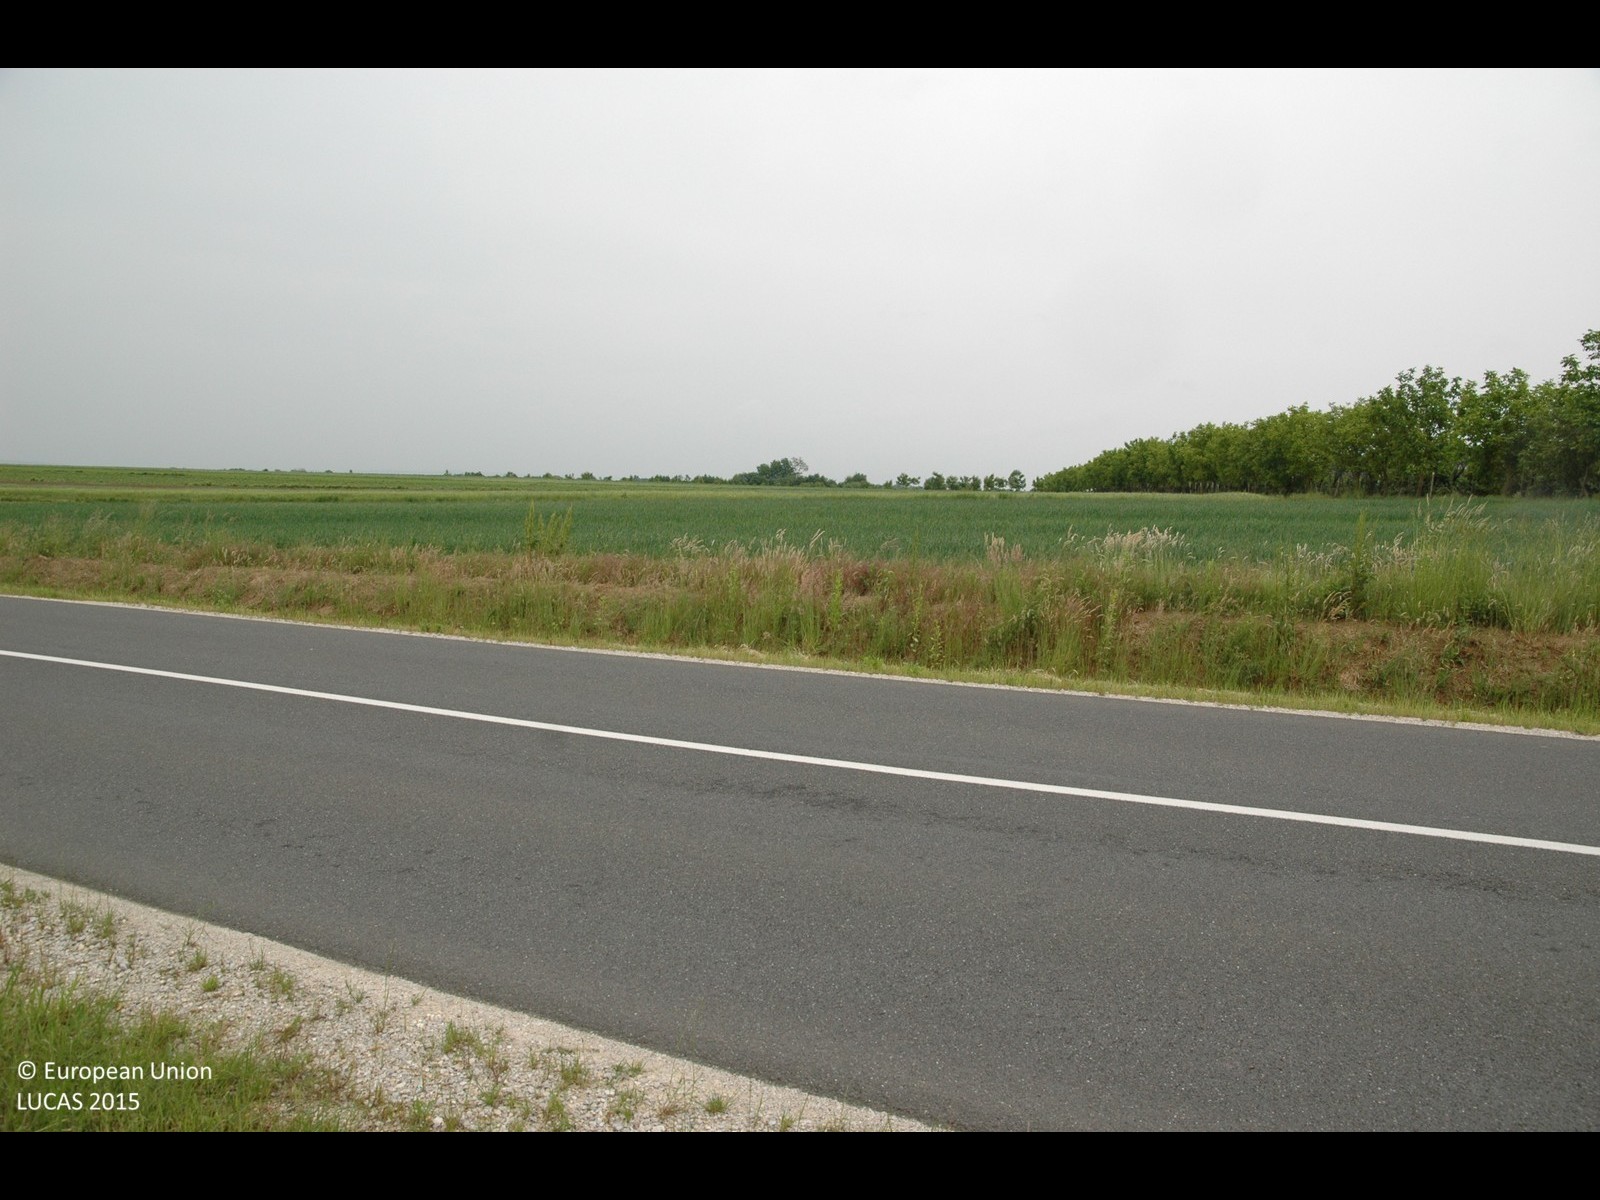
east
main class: Cropland
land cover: Apple fruit
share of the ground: 50 - 75 %
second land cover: Grassland without tree/shrub cover
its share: 50 - 75 %
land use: Agriculture (excluding fallow land and kitchen gardens)
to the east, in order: Apple fruit; Grassland without tree/shrub cover; Fences; Grass margins; Ditches and canals; Paved roads, cycling and walking lanes; Grass margins; Ditches and canals; Grass margins; Common wheat; Maize; Common wheat; Barley; Maize; Potatoes; Maize
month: May
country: HR
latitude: 46.4638
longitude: 16.4466
